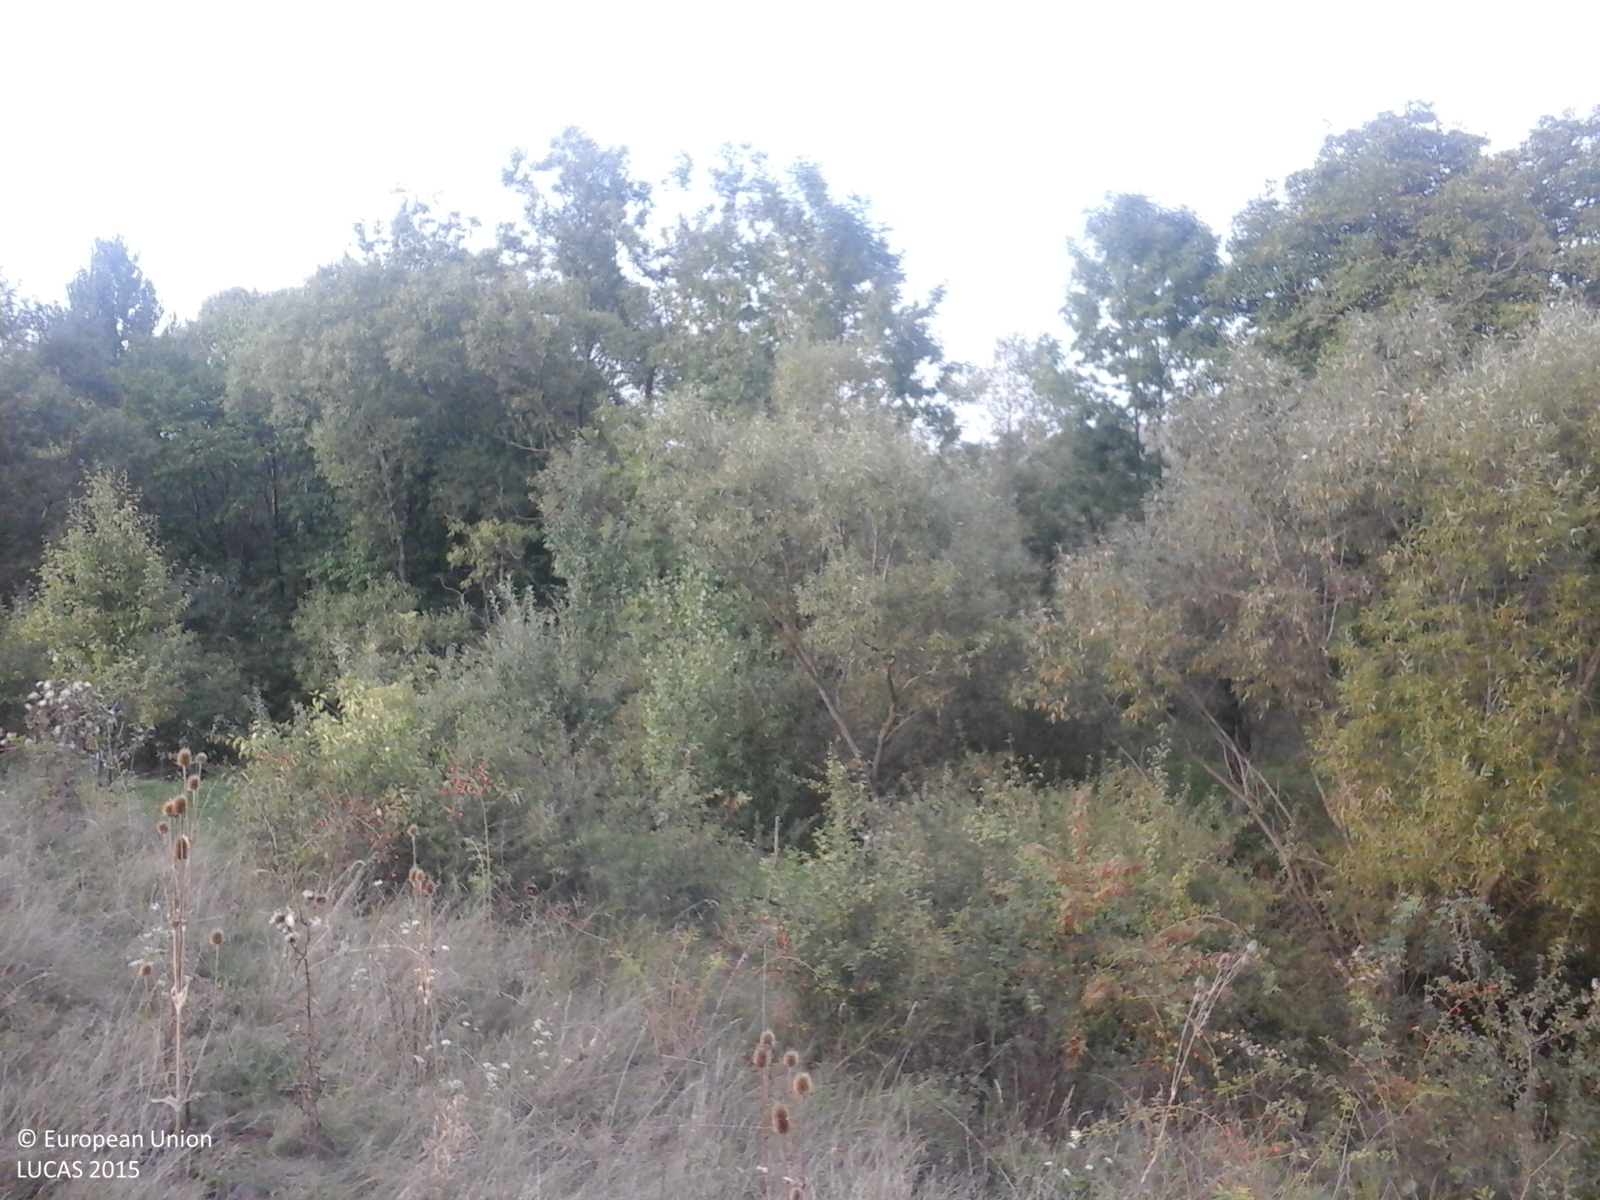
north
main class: Grassland
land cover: Grassland with sparse tree/shrub cover
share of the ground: > 75 %
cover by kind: herbaceous plants 85 %, shrubs 10 %, broadleaved forest trees 5 %
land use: Fallow land
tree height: < 5 m
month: September
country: RO
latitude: 46.8269
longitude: 23.0264
